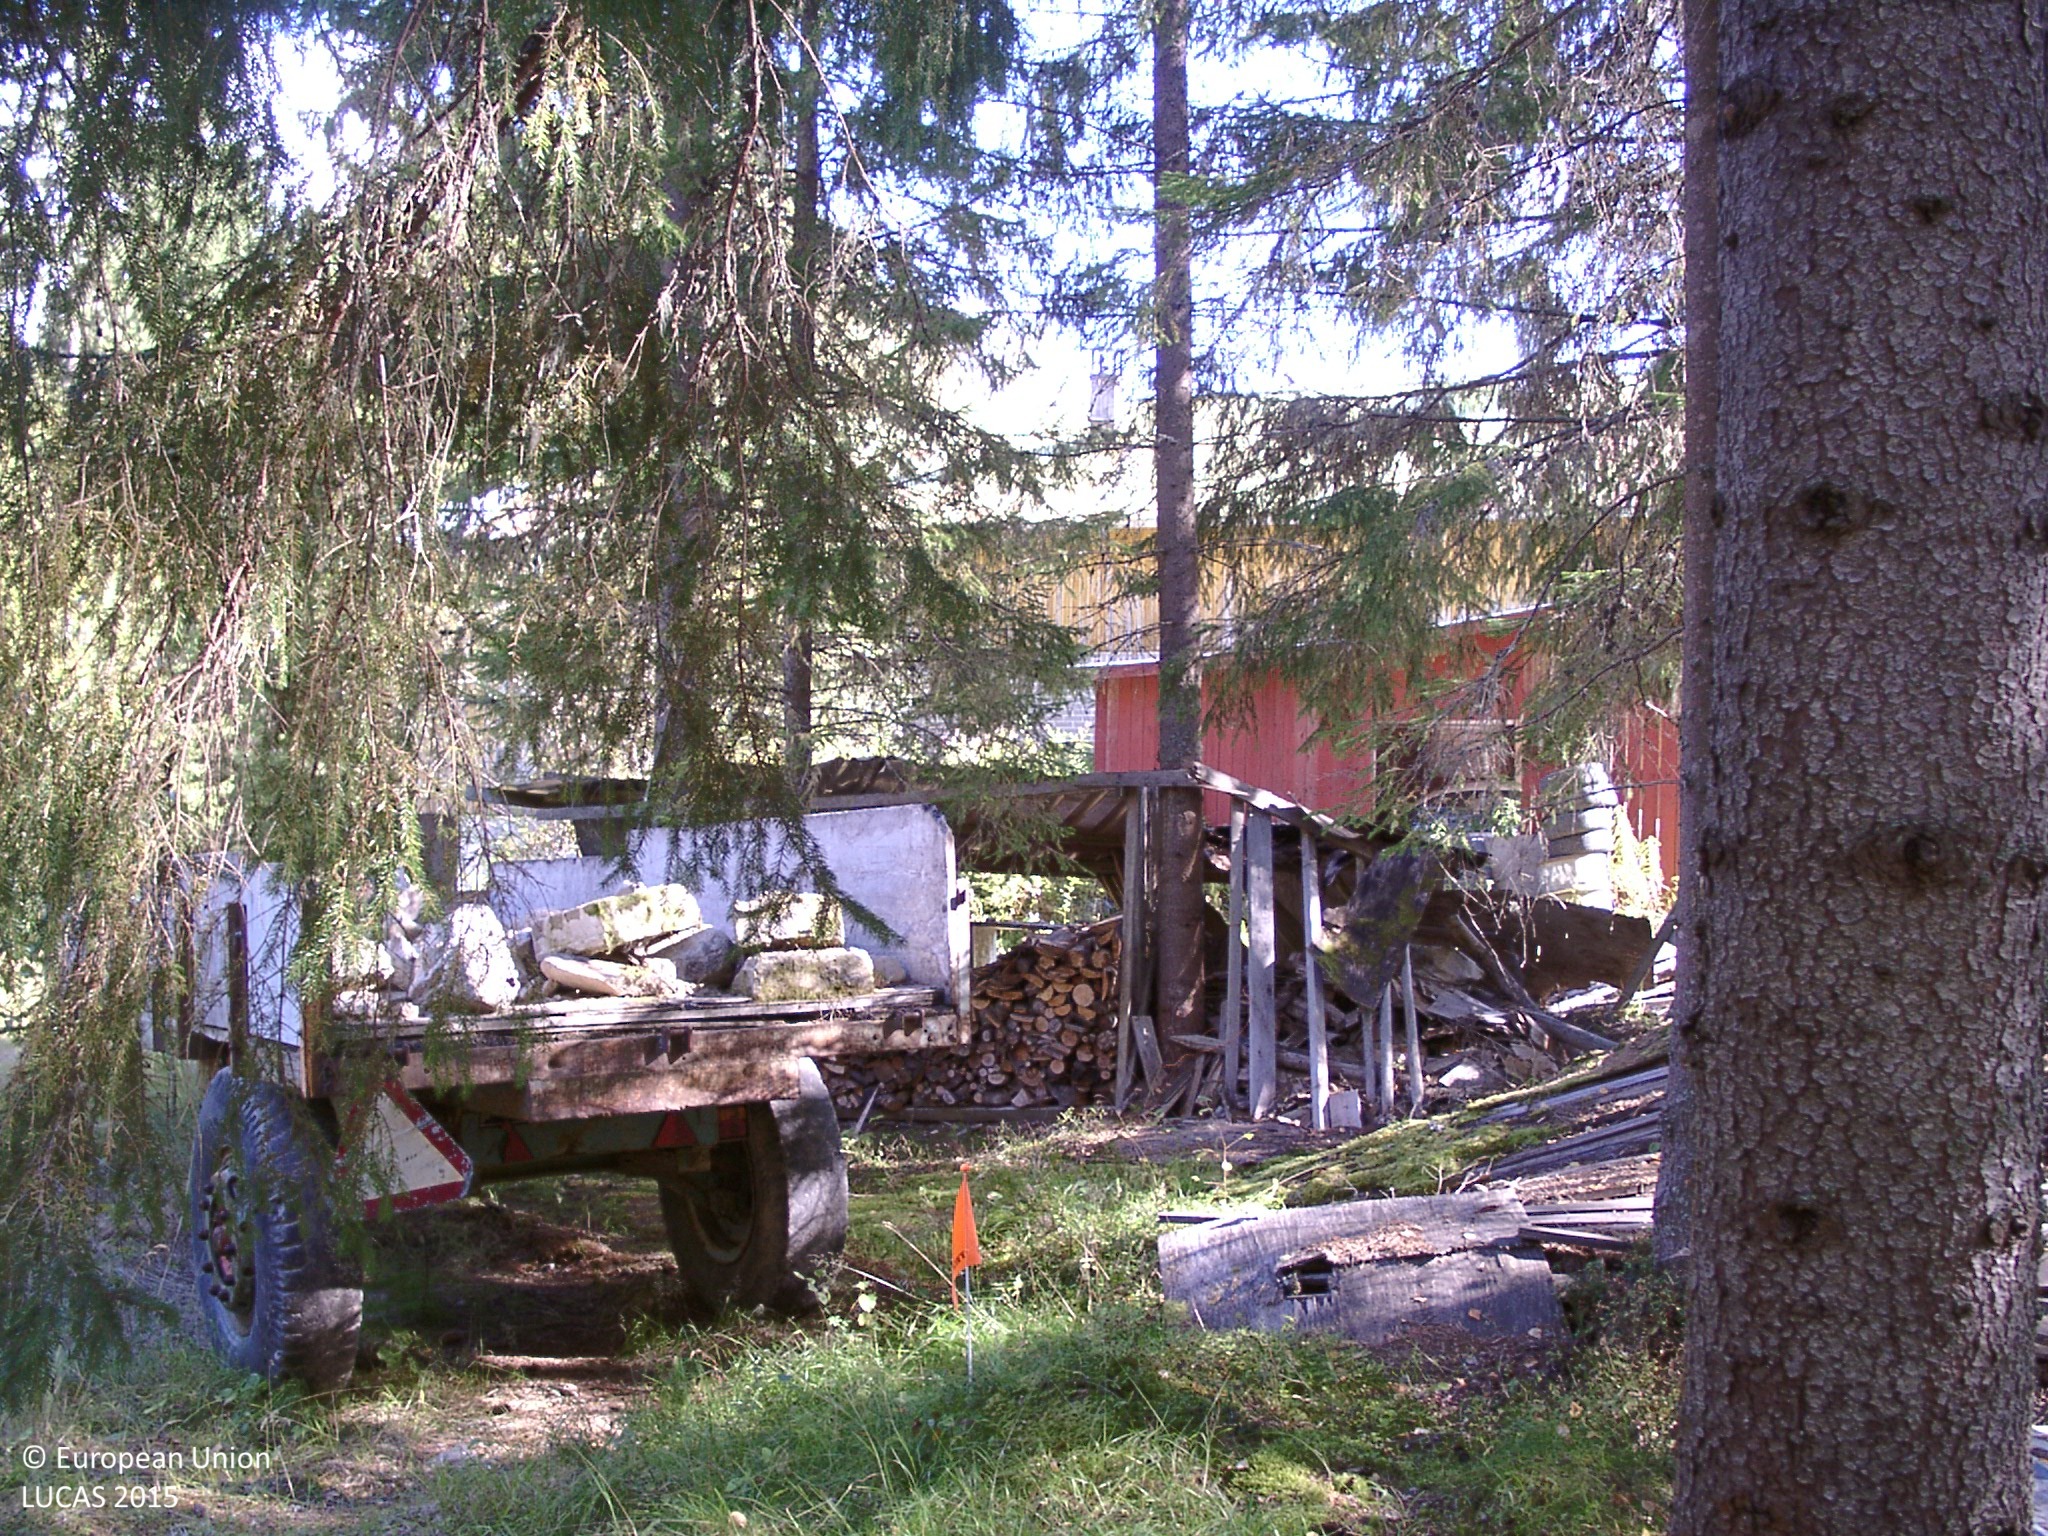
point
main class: Grassland
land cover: Grassland with sparse tree/shrub cover
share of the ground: 50 - 75 %
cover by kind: herbaceous plants 50 %, unconsolidated bare surface 15 %, lichens and mosses 10 %, broadleaved forest trees 5 %
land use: Residential
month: September
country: FI
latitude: 62.4692
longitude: 25.6491
